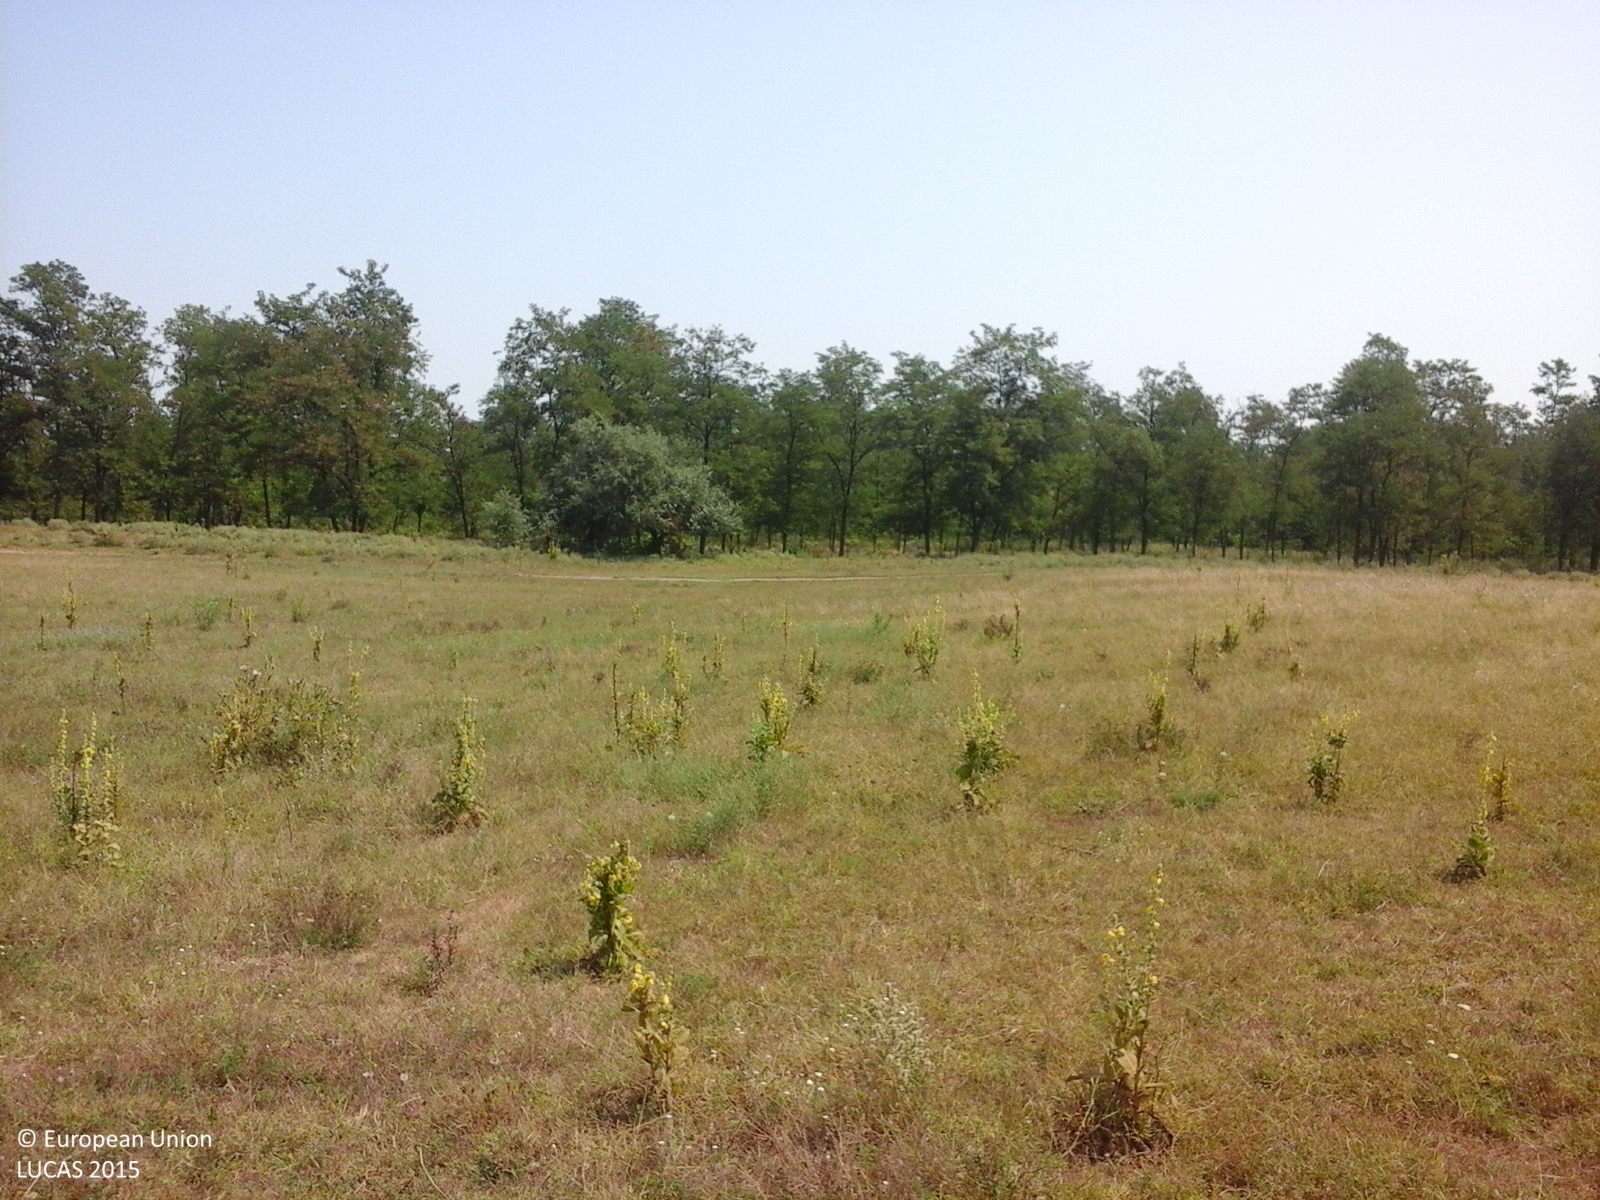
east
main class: Grassland
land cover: Grassland without tree/shrub cover
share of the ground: > 75 %
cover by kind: herbaceous plants 100 %
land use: Agriculture (excluding fallow land and kitchen gardens)
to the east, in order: Grassland without tree/shrub cover; Tracks; Spontaneously vegetated surfaces; Broadleaved woodland; Tracks; Broadleaved woodland
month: August
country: RO
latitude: 43.8542
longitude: 23.1674
